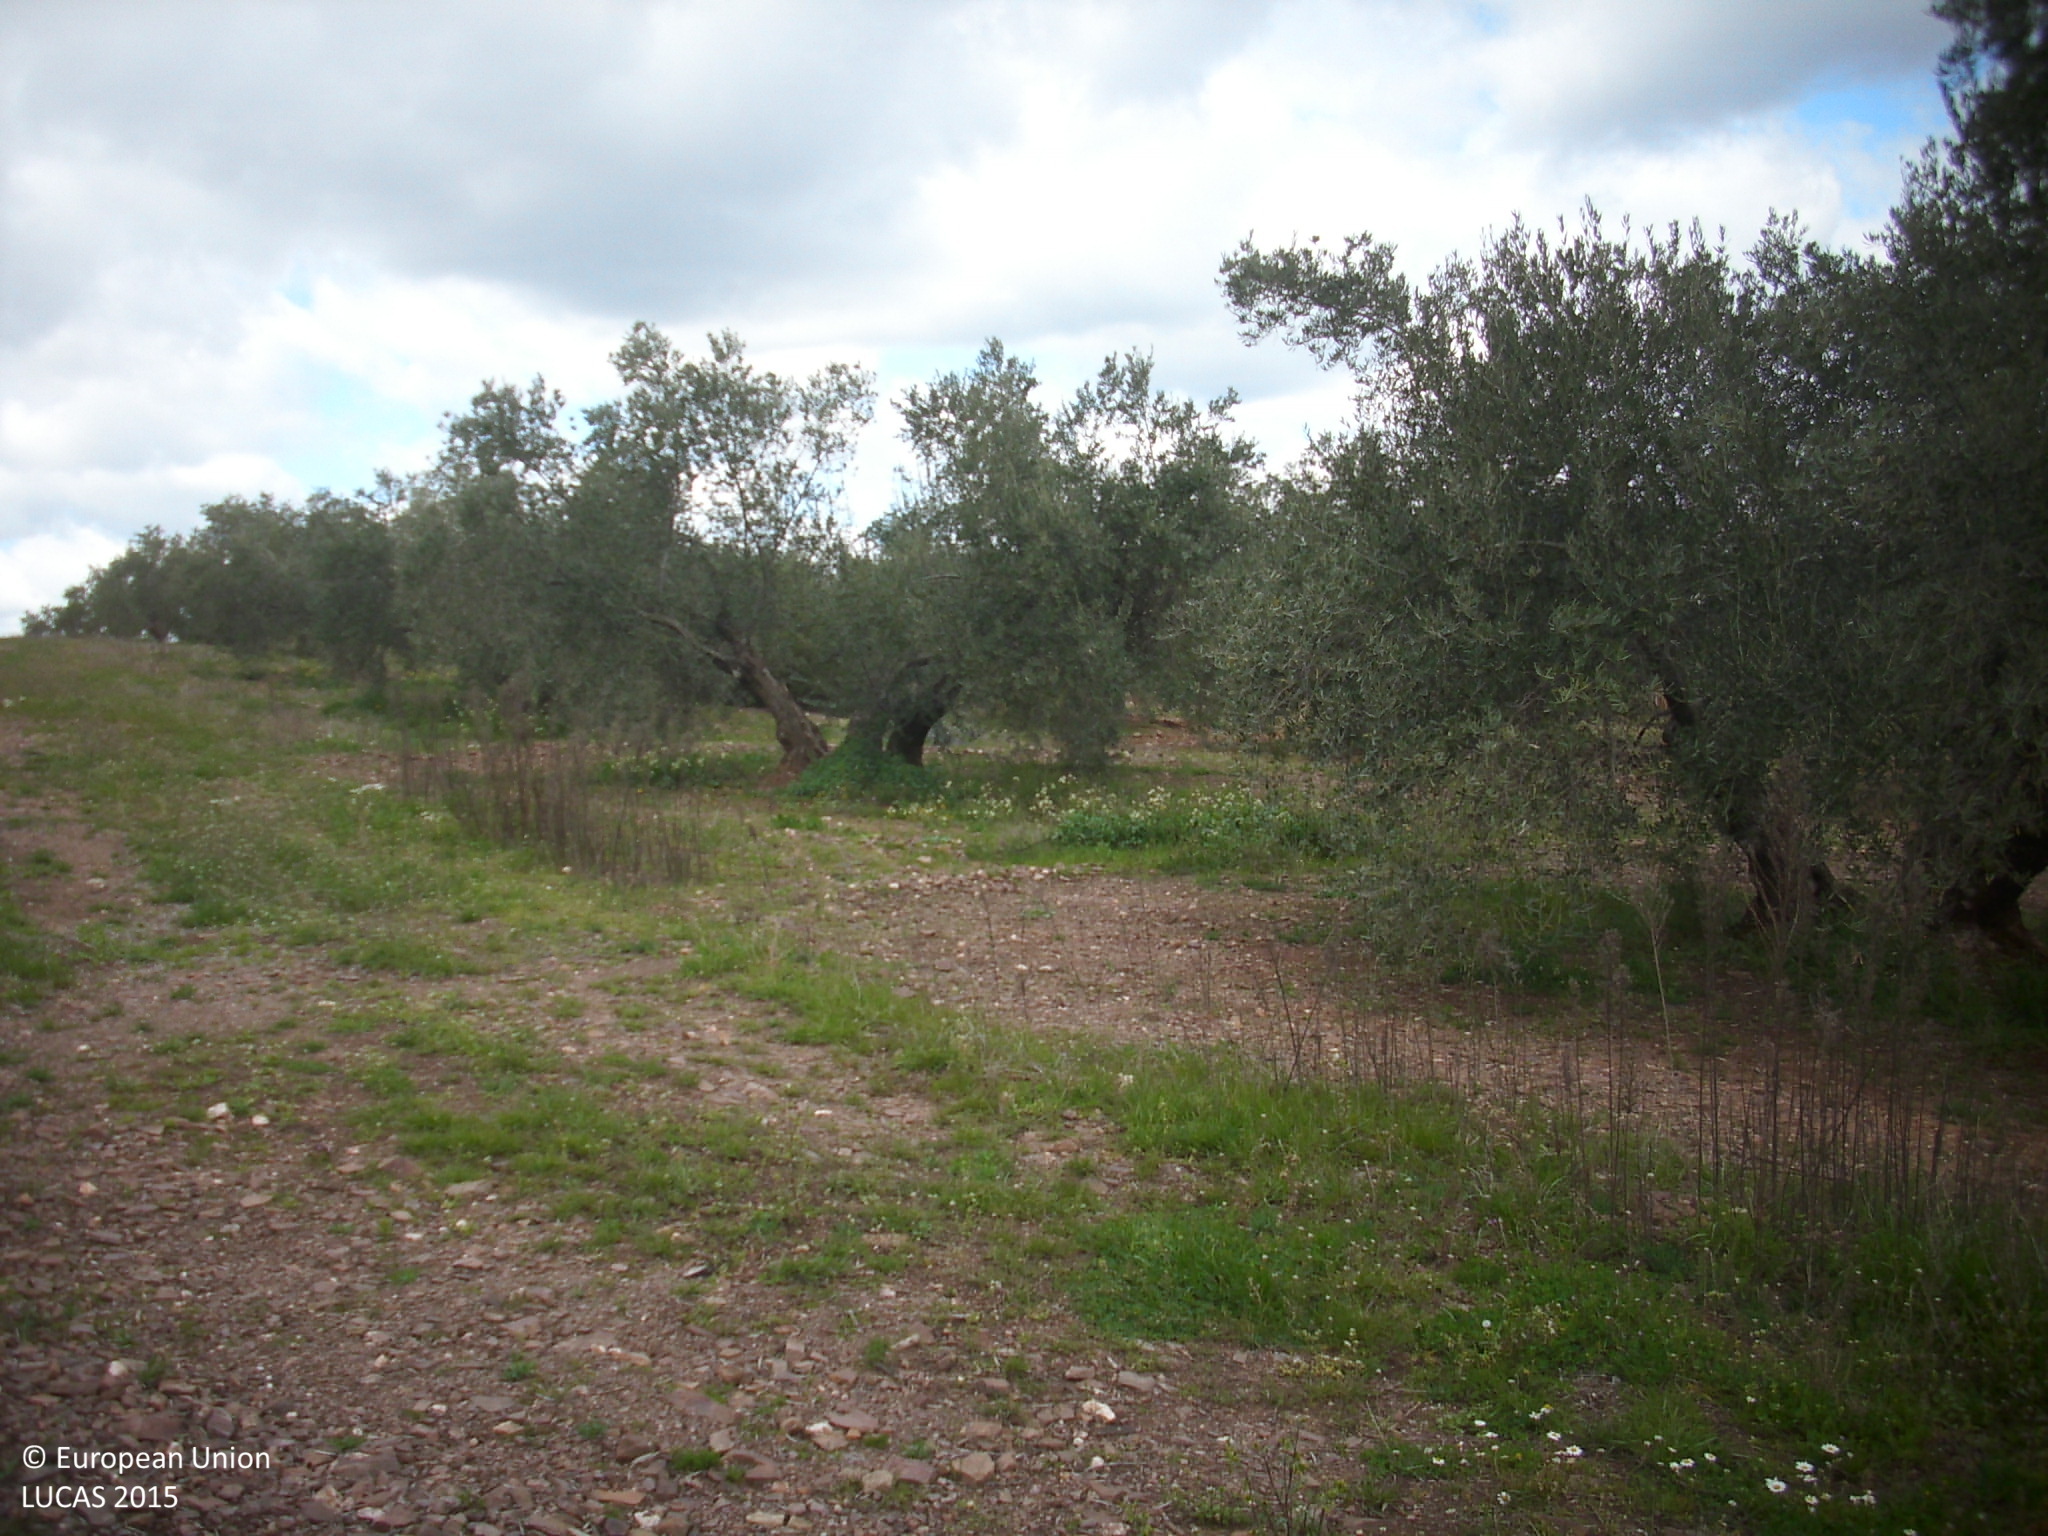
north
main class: Cropland
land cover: Olive groves
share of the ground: 25 - 50 %
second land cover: Spontaneously vegetated surfaces
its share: > 75 %
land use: Agriculture (excluding fallow land and kitchen gardens)
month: March
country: ES
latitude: 38.3552
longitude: -3.1283
